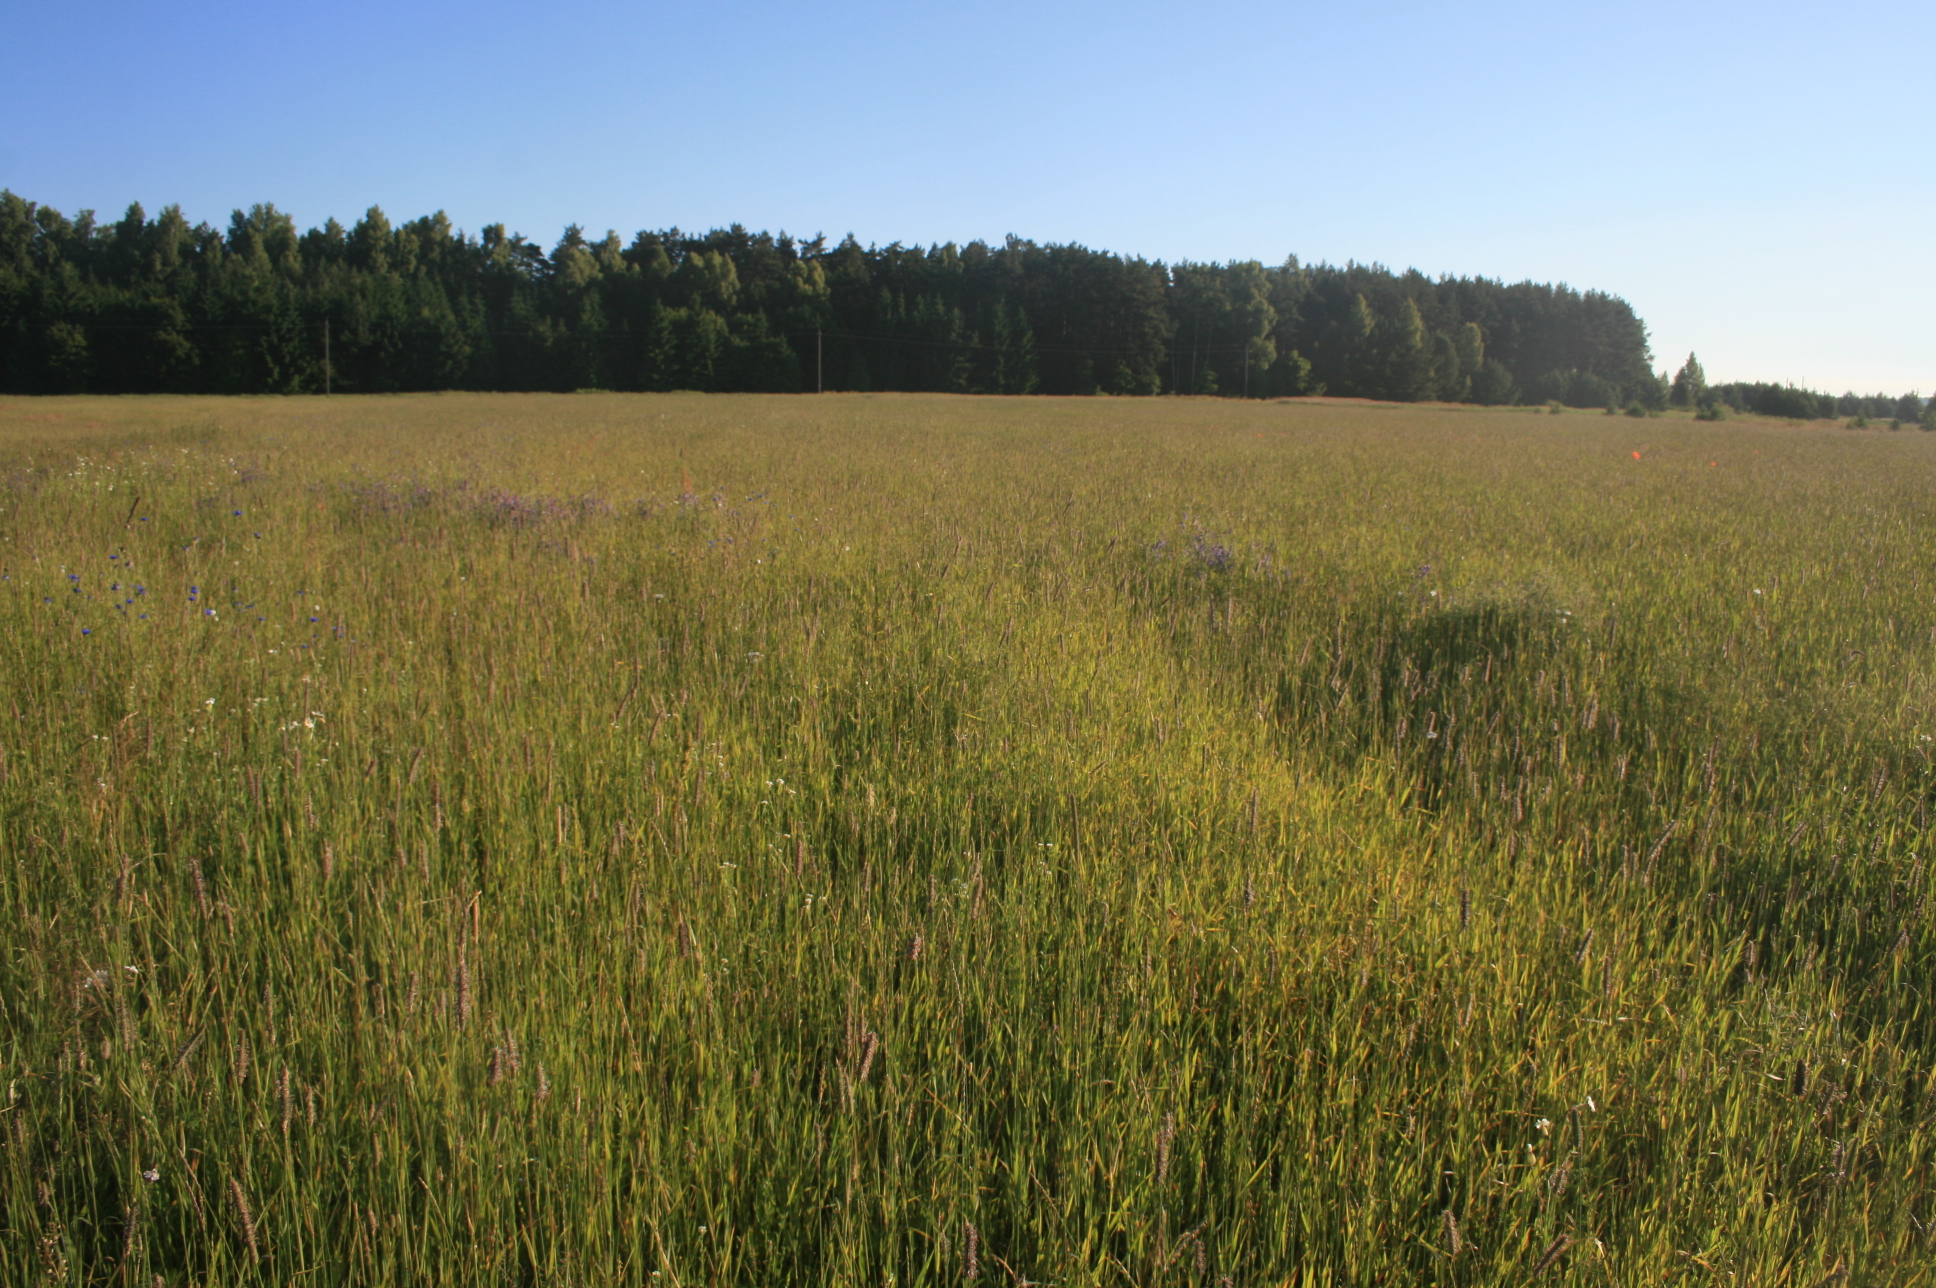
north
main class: Grassland
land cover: Grassland without tree/shrub cover
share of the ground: > 75 %
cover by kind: herbaceous plants 100 %
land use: Agriculture (excluding fallow land and kitchen gardens)
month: June
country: LT
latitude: 55.3230
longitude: 21.5039
